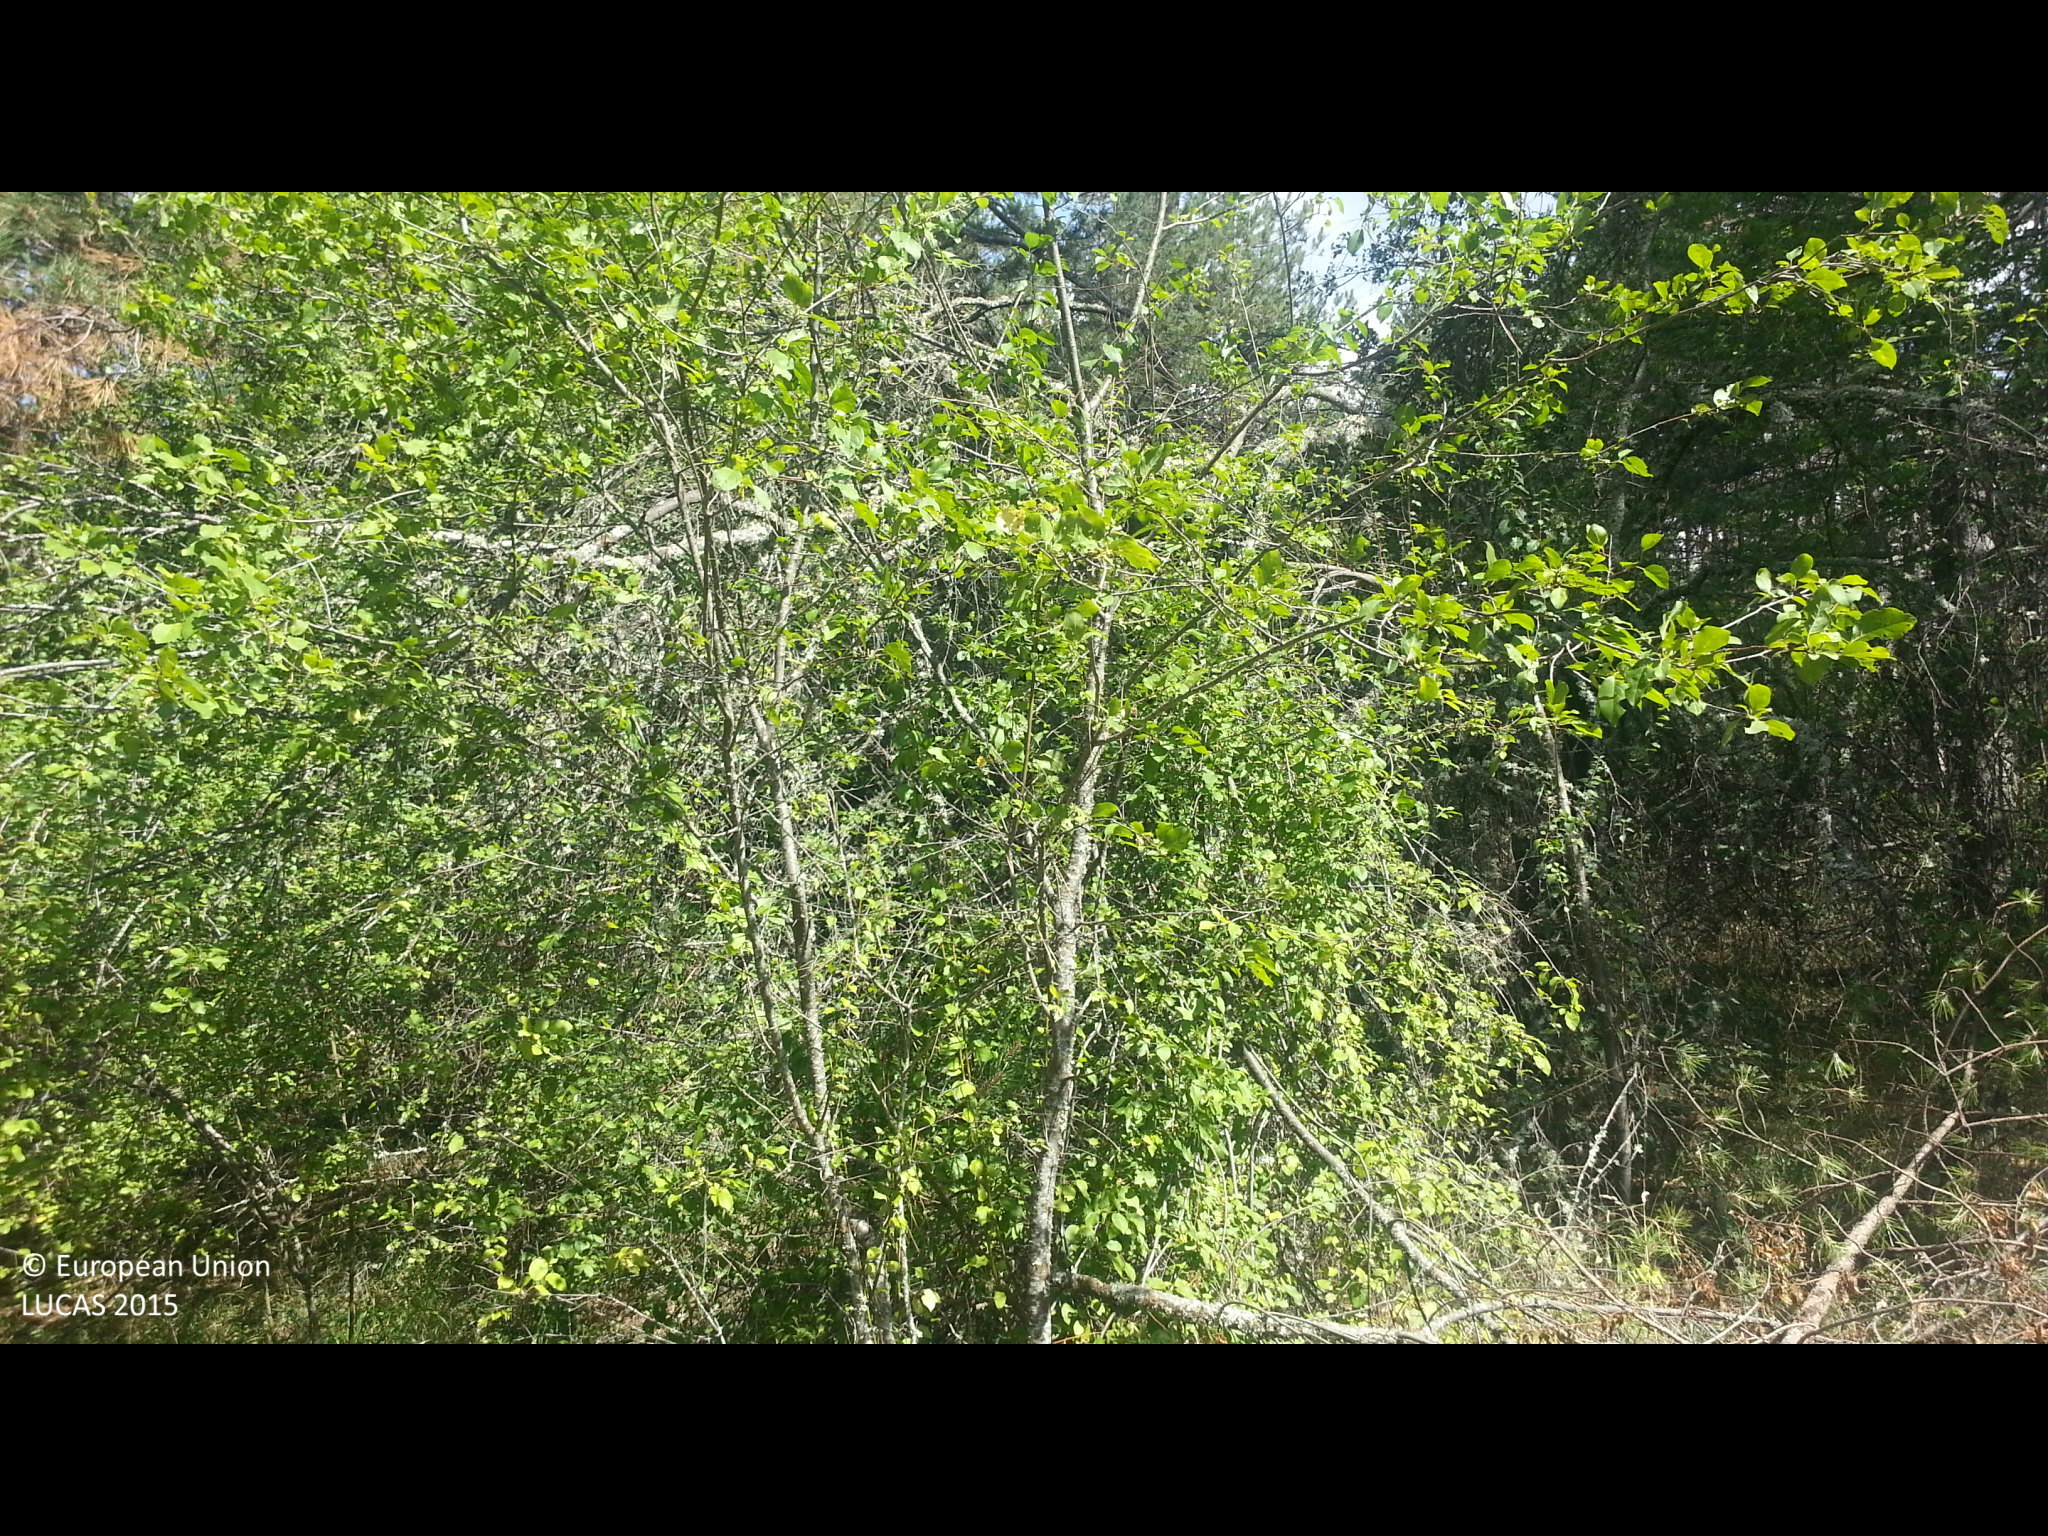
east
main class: Woodland
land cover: Pine dominated mixed woodland
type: hemiboreal forest and nemoral coniferous forest and mixed broadleaved-coniferous forest
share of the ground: > 75 %
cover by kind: coniferous forest trees 65 %, broadleaved forest trees 25 %, herbaceous plants 10 %
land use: Forestry
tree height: < 5 m
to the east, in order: Pine dominated mixed woodland; Tracks; Pine dominated mixed woodland; Grassland with sparse tree/shrub cover; Pine dominated mixed woodland; Tracks; Pine dominated coniferous woodland
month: September
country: BG
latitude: 42.4294
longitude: 22.6023
